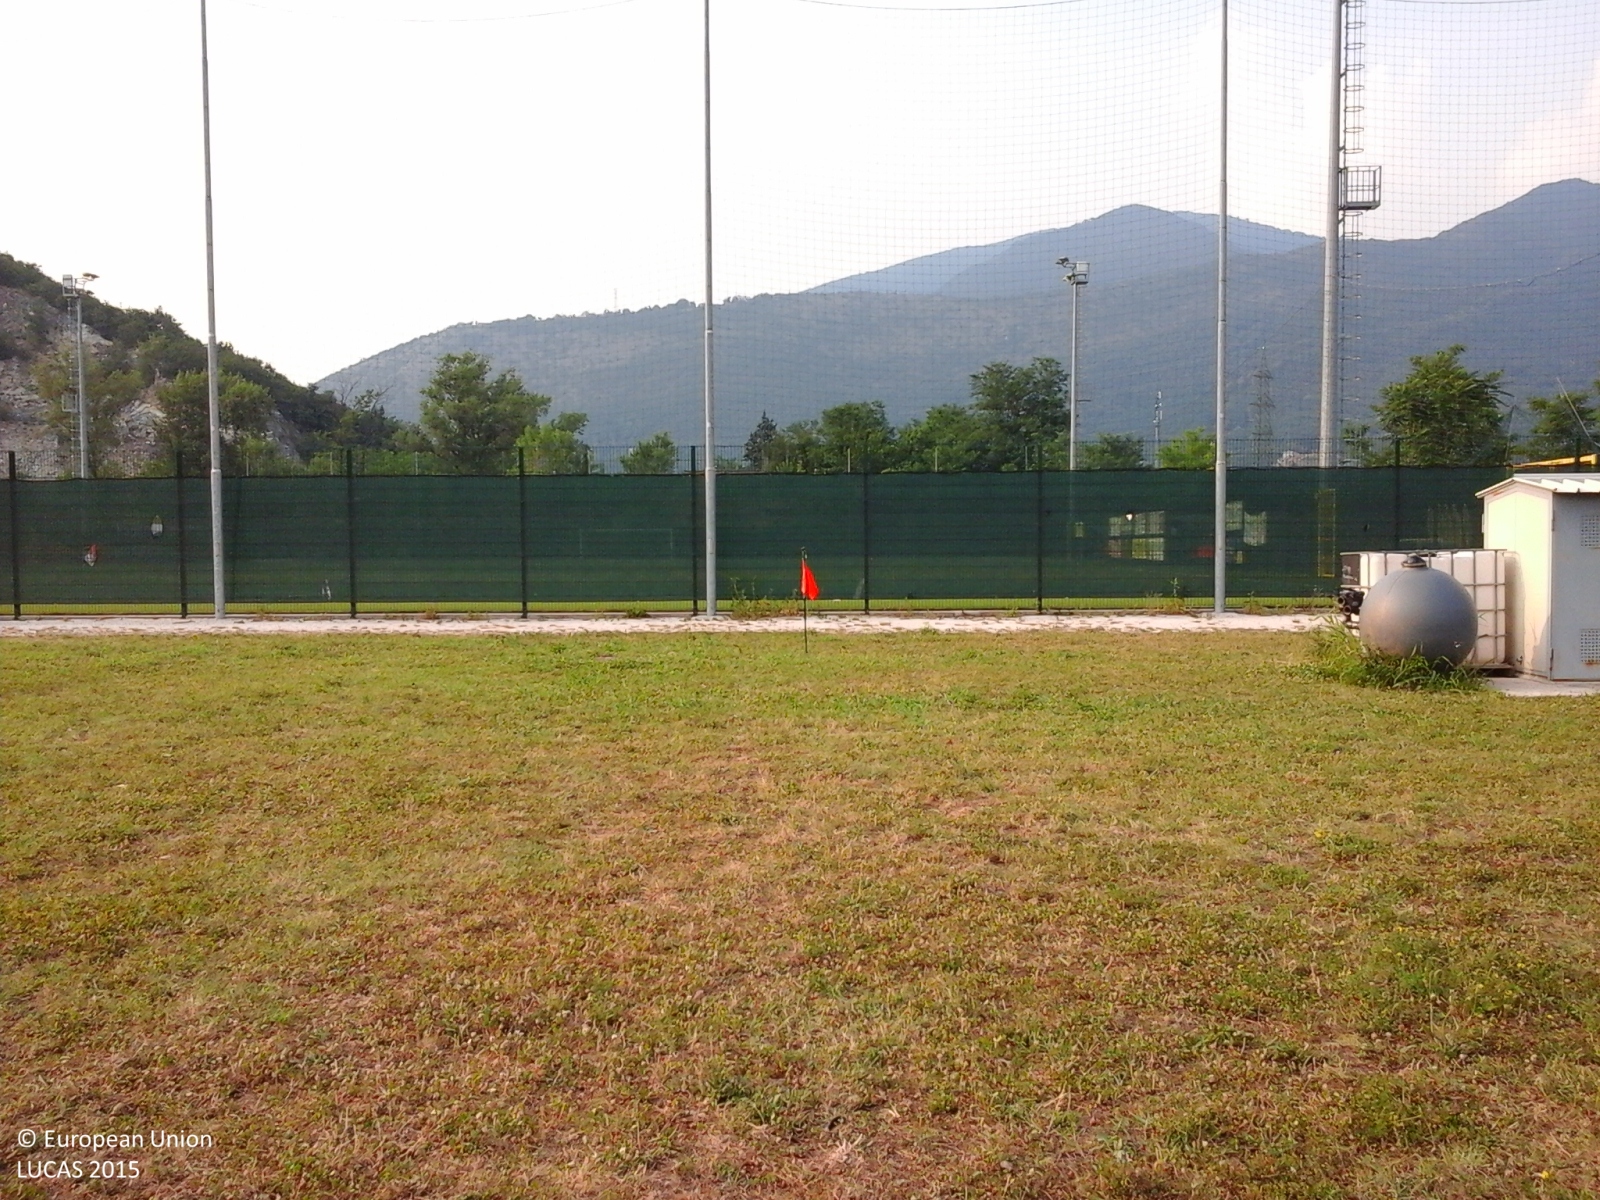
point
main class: Grassland
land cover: Grassland without tree/shrub cover
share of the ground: > 75 %
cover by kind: herbaceous plants 100 %
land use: Amenities, museums, leisure
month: June
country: IT
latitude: 45.5943
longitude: 10.2176
